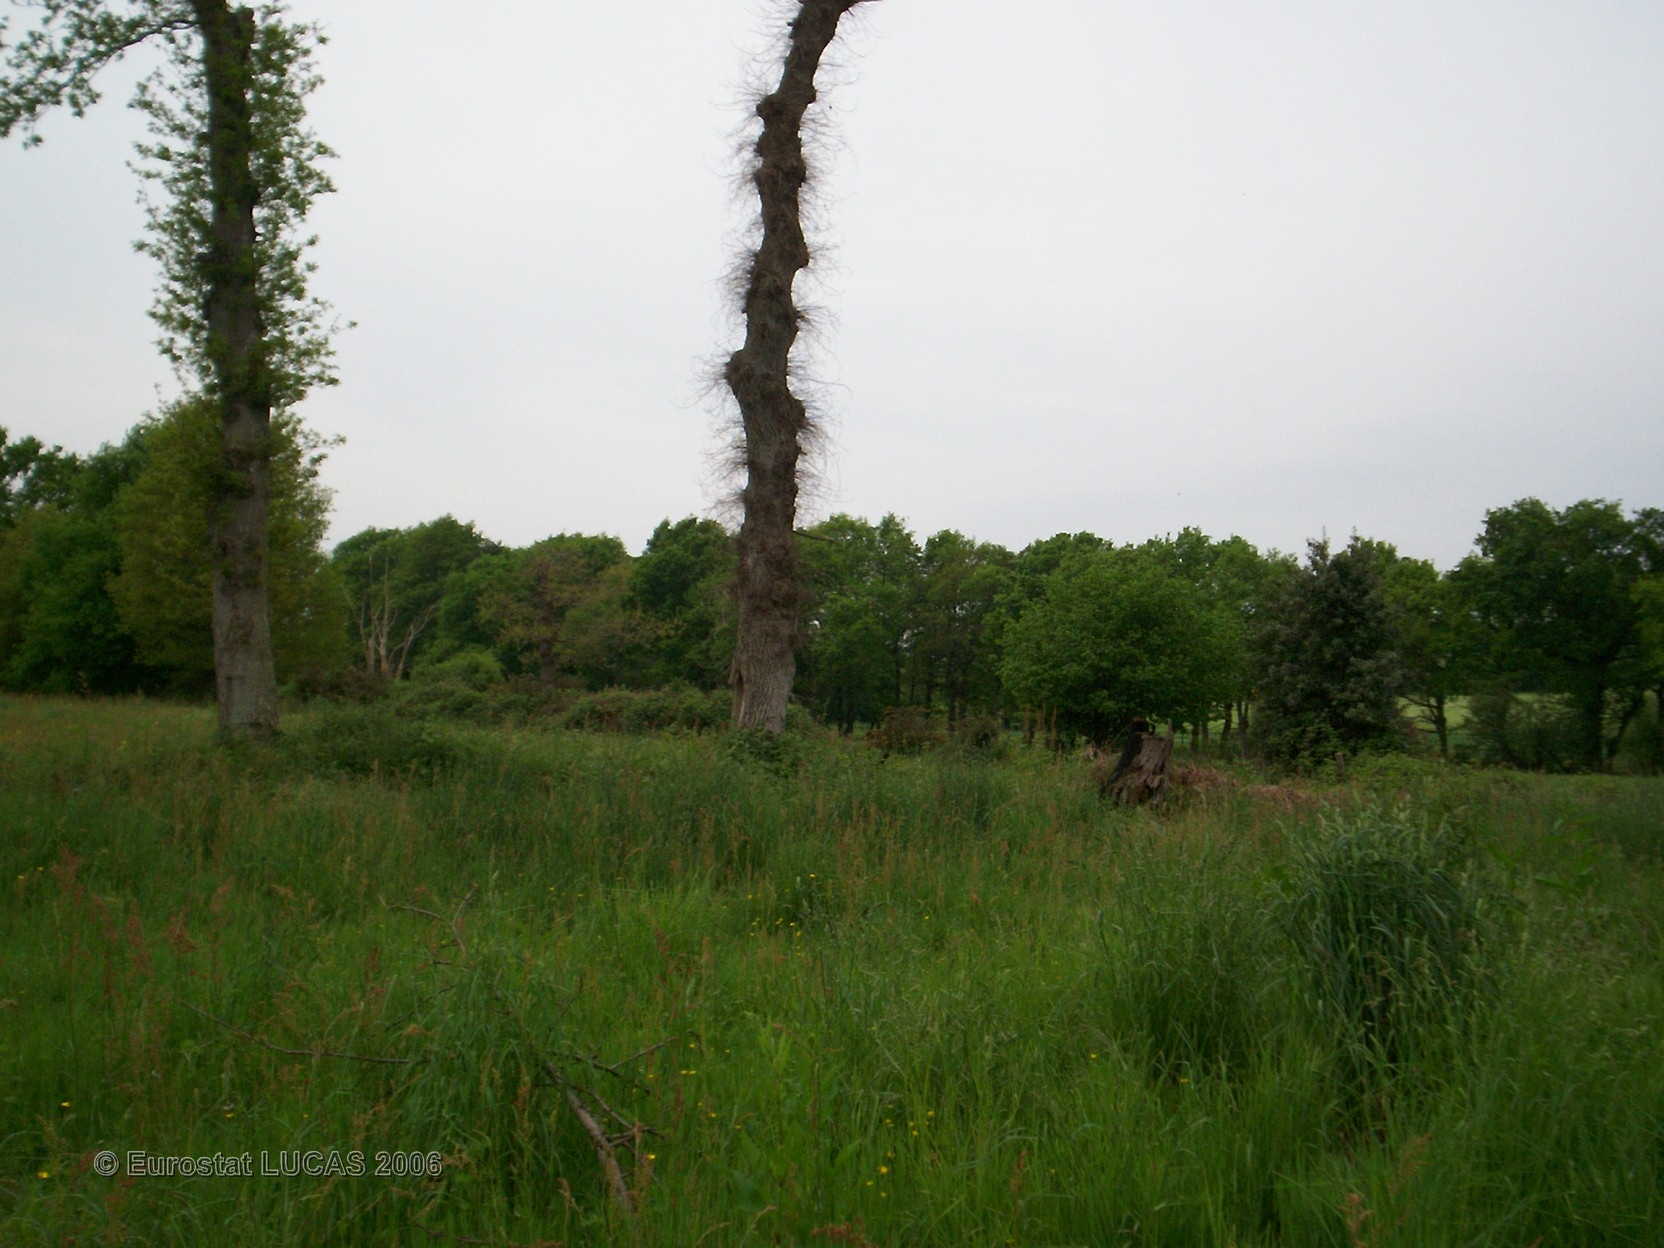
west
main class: Cropland
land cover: Apple fruit
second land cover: Grassland with sparse tree/shrub cover
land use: Agriculture (excluding fallow land and kitchen gardens)
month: May
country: FR
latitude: 48.3116
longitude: -1.6581
